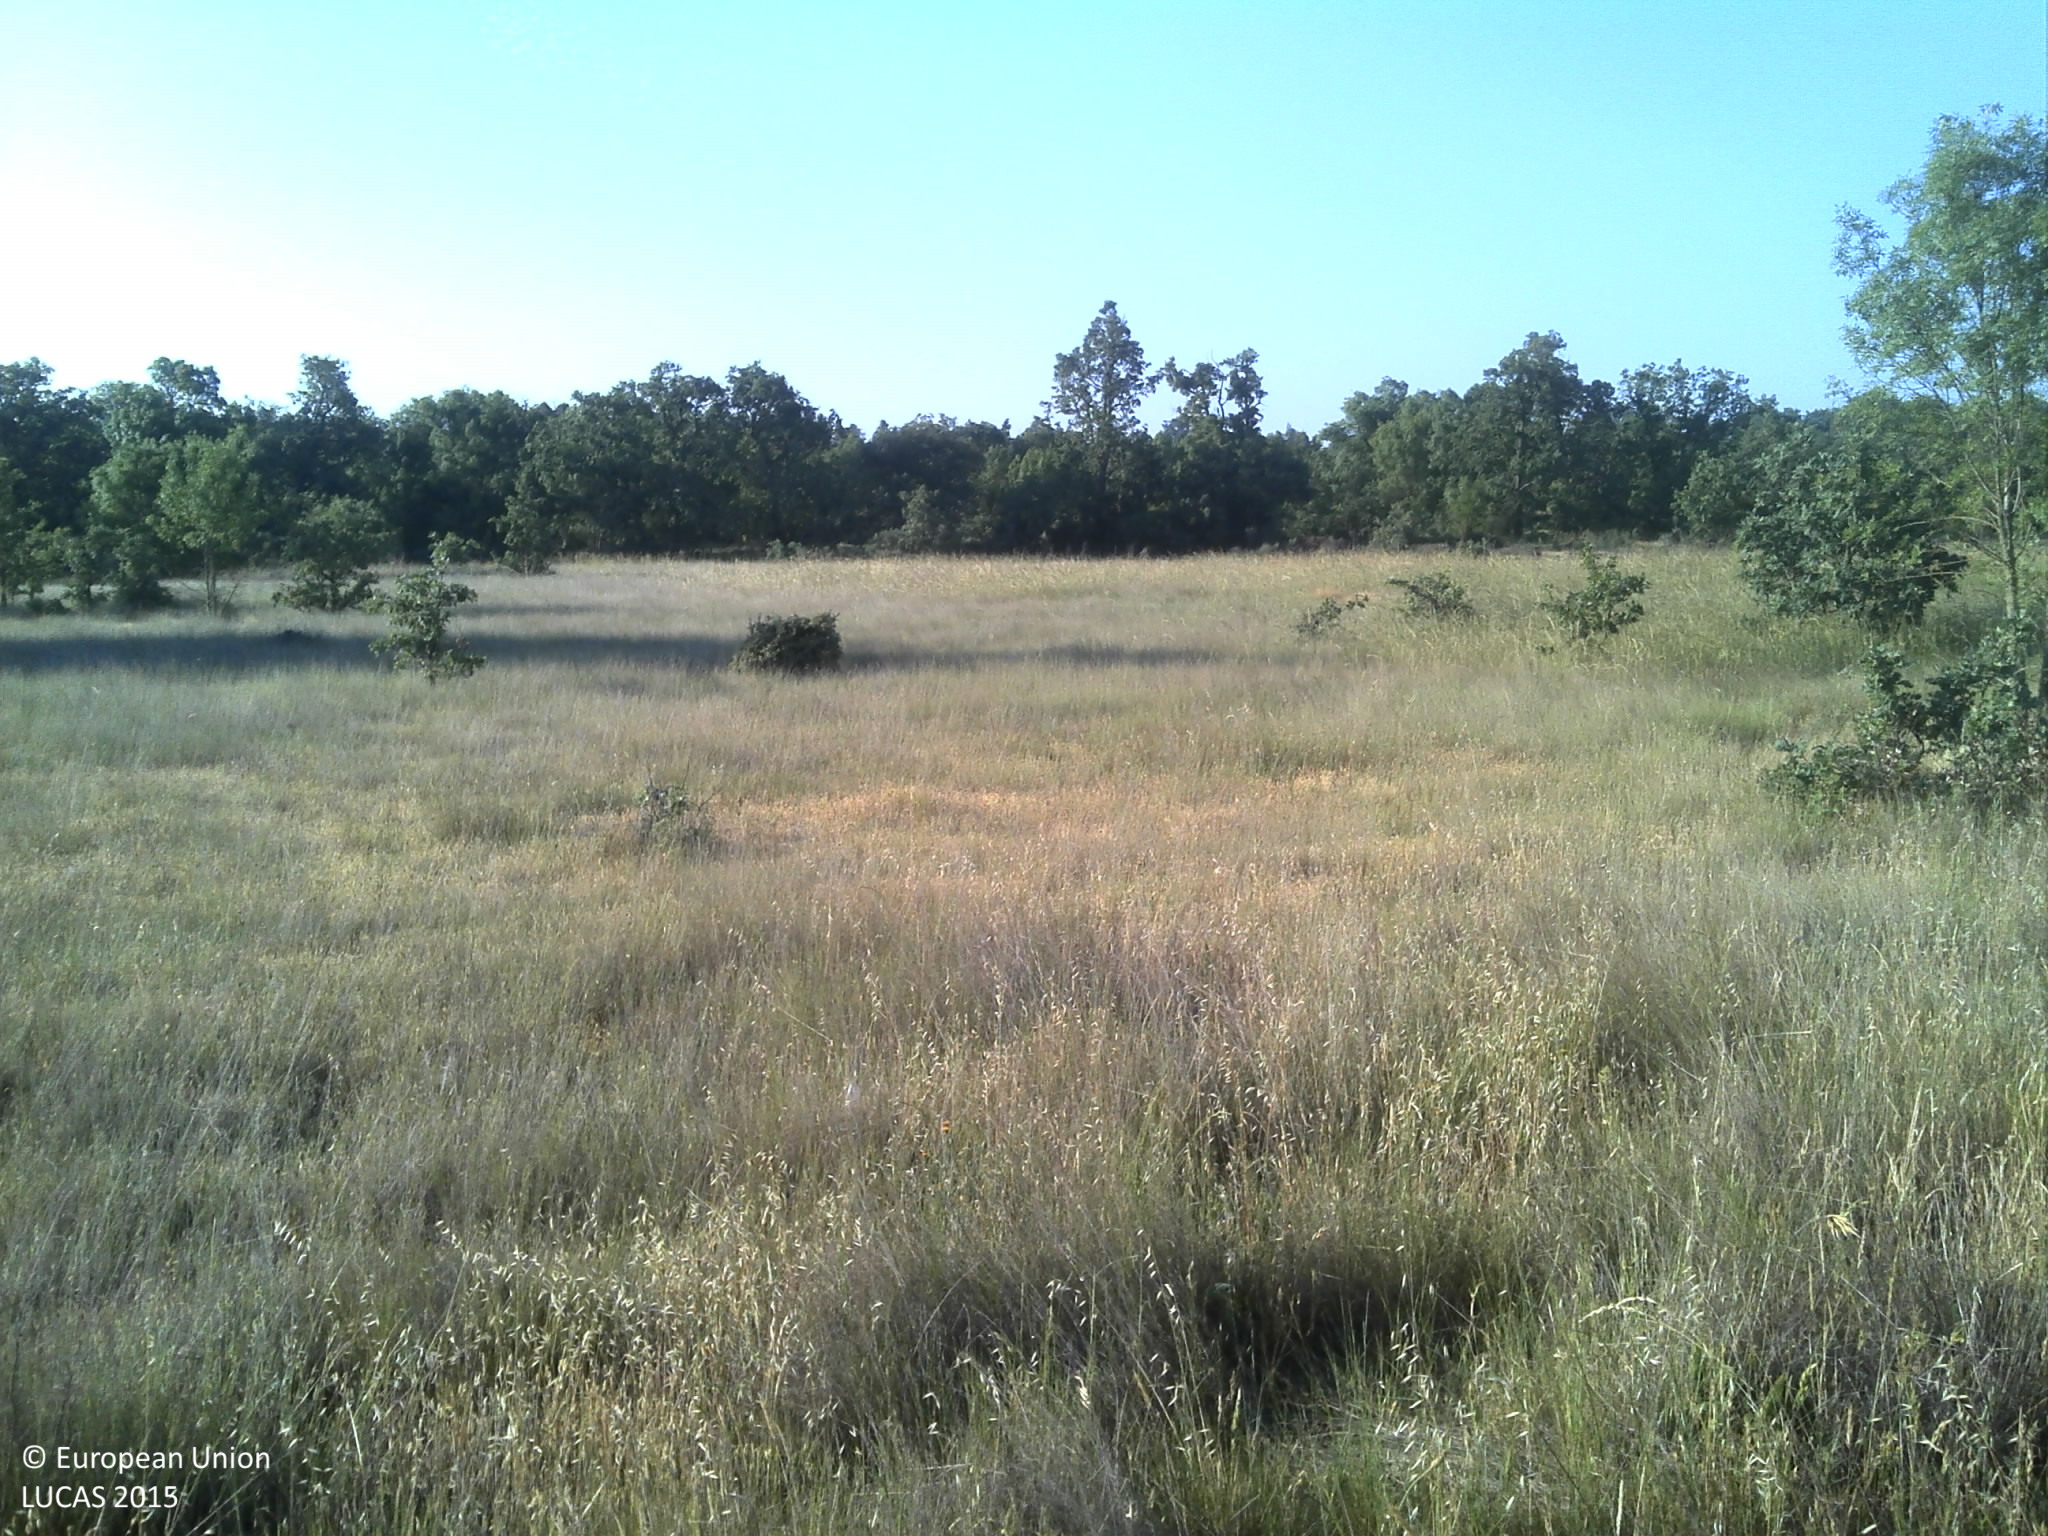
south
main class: Grassland
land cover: Grassland without tree/shrub cover
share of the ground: 50 - 75 %
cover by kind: herbaceous plants 70 %, unconsolidated bare surface 20 %
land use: Agriculture (excluding fallow land and kitchen gardens)
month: June
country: PT
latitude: 40.5637
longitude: -6.9772
